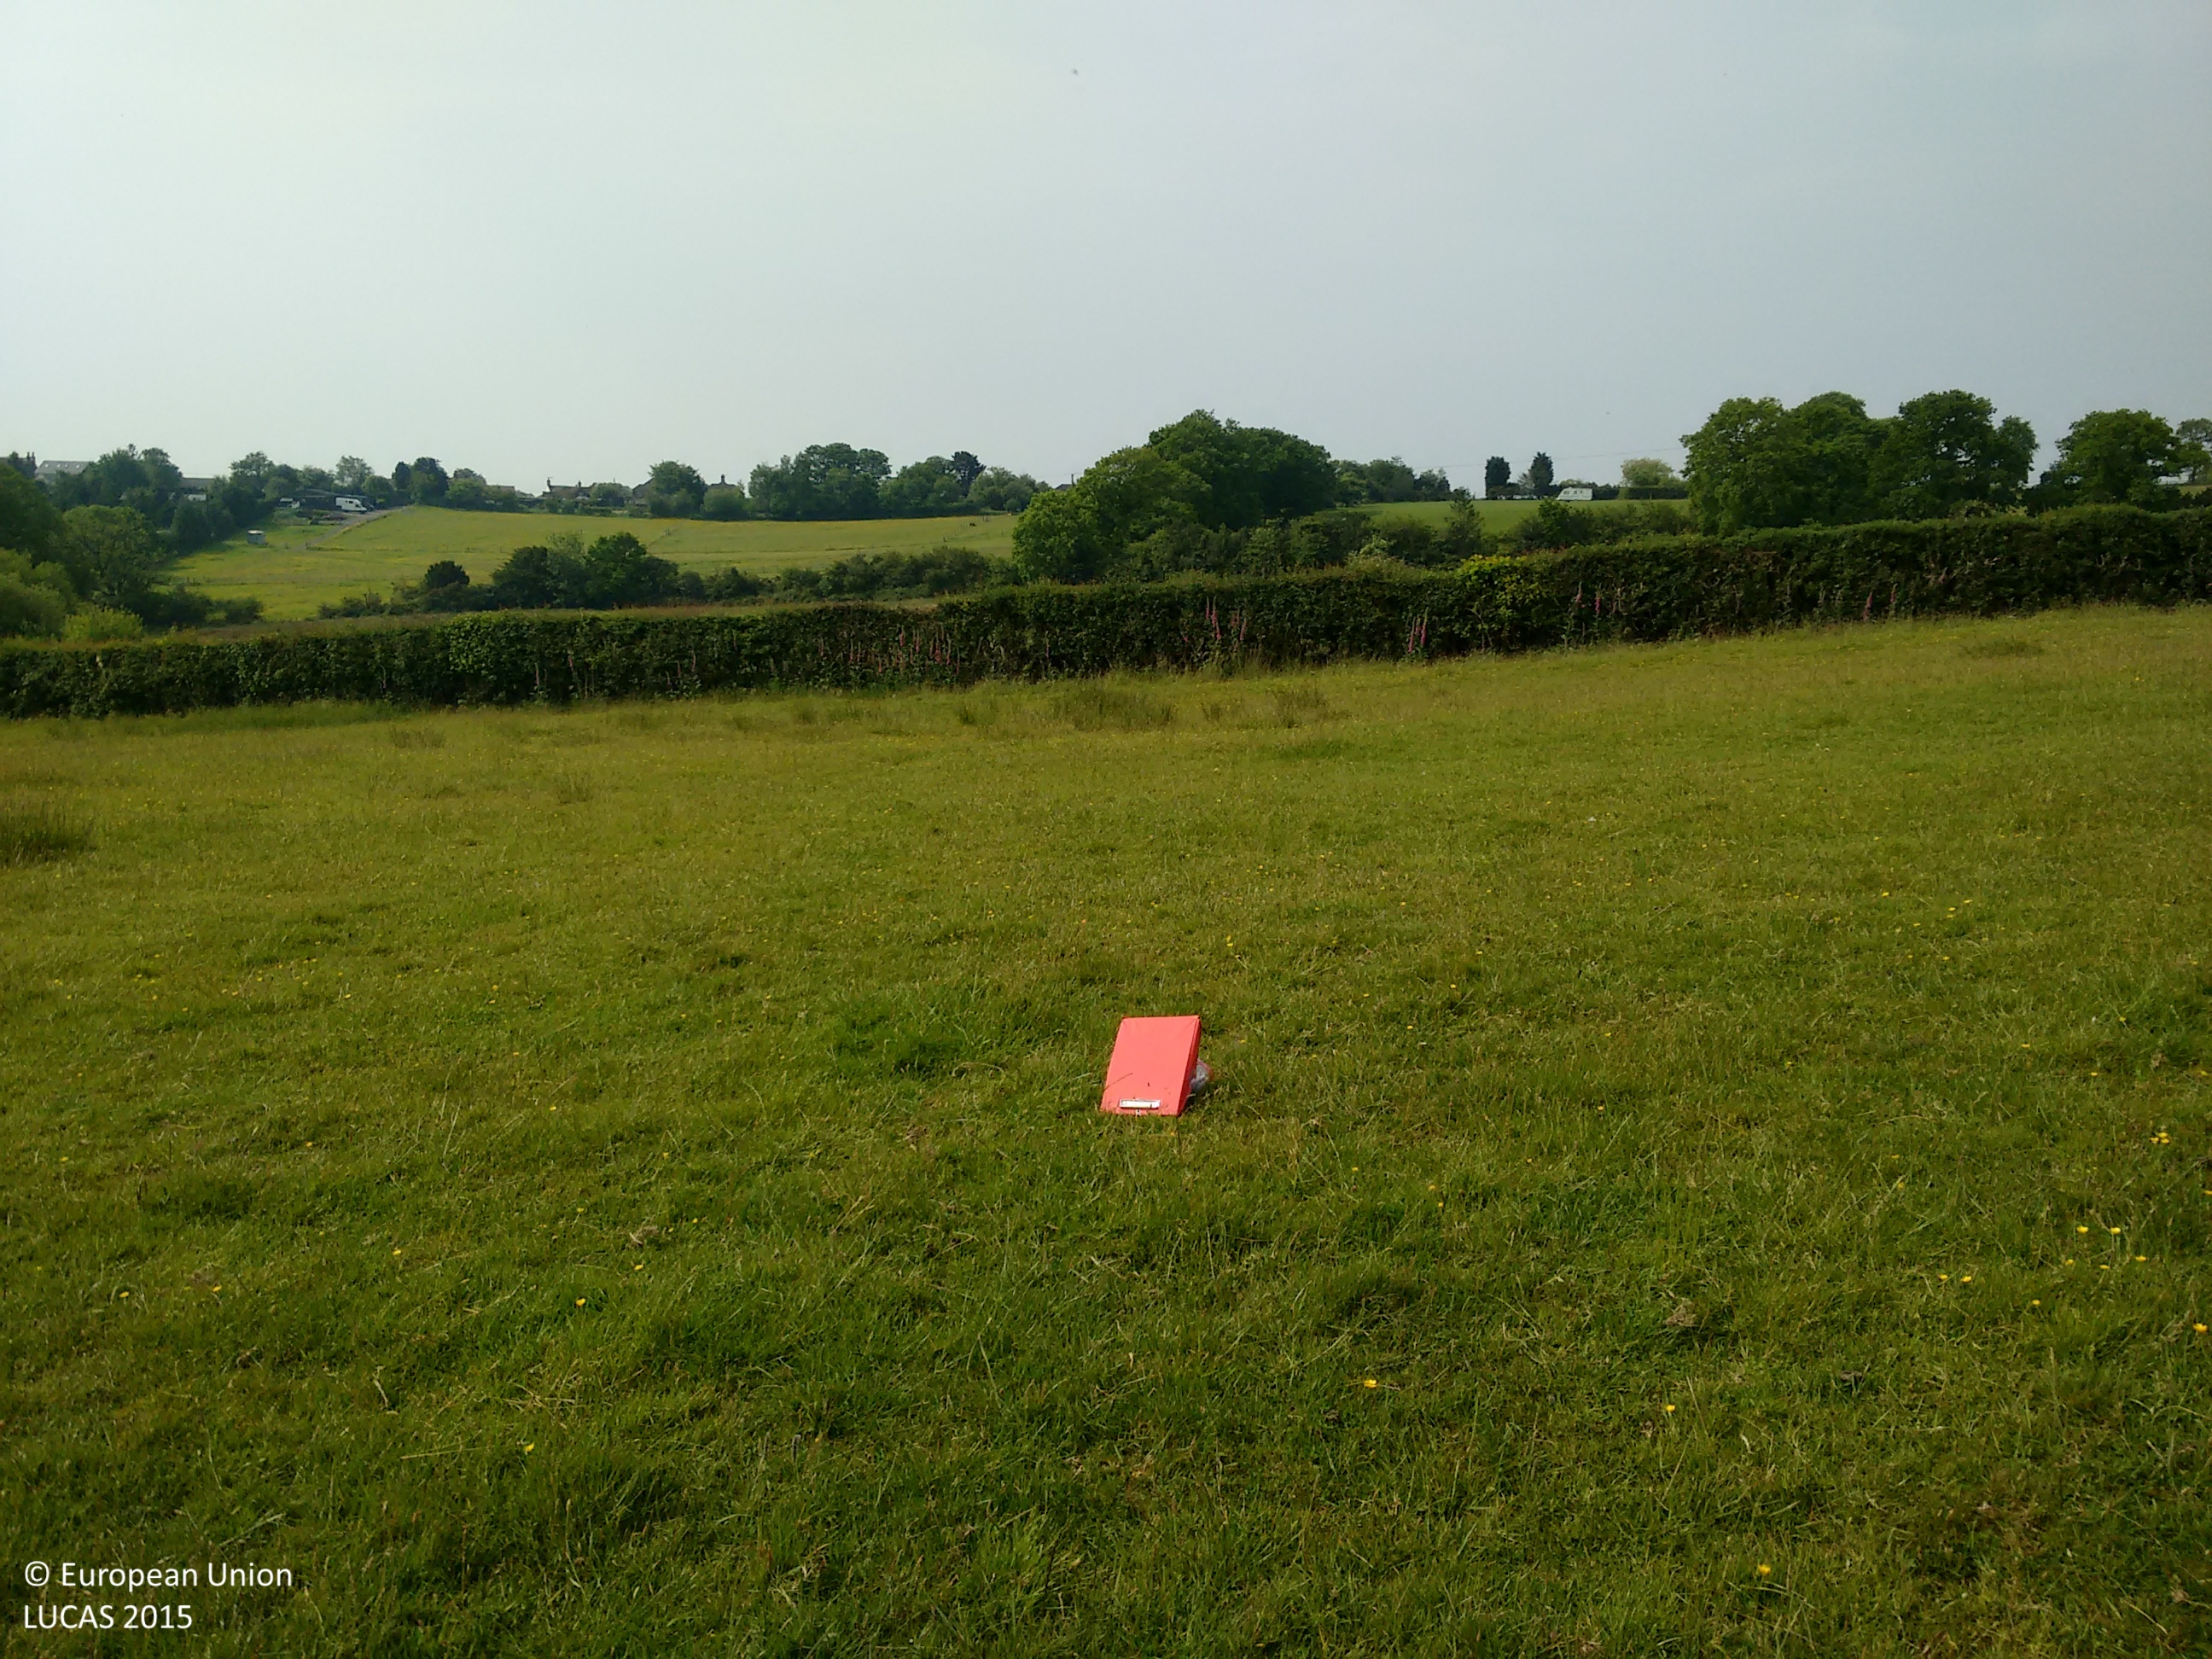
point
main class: Grassland
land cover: Grassland without tree/shrub cover
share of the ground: > 75 %
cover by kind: herbaceous plants 100 %
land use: Agriculture (excluding fallow land and kitchen gardens)
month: June
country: GB
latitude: 50.9653
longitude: 0.3020
